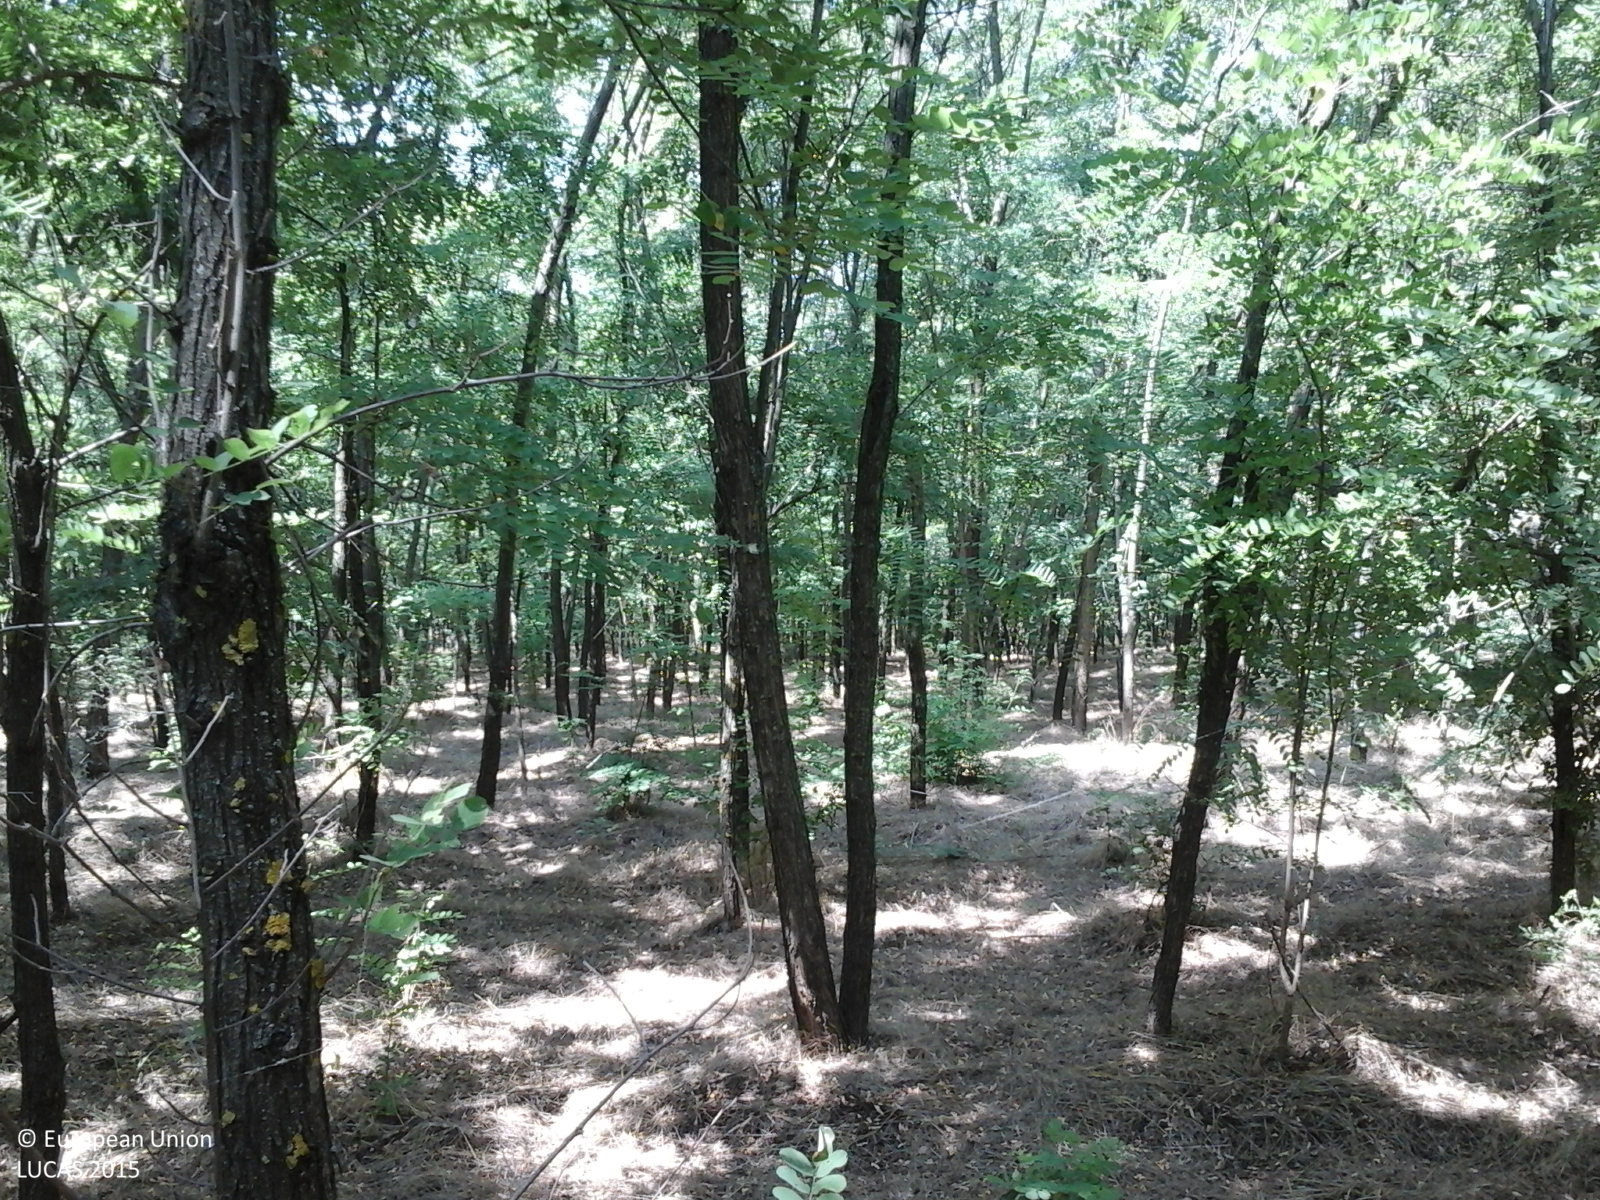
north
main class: Woodland
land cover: Broadleaved woodland
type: broadleaved evergreen forest
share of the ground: > 75 %
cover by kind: broadleaved forest trees 90 %, herbaceous plants 10 %
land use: Forestry
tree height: > 5 m
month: July
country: RO
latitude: 44.9159
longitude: 27.1497
